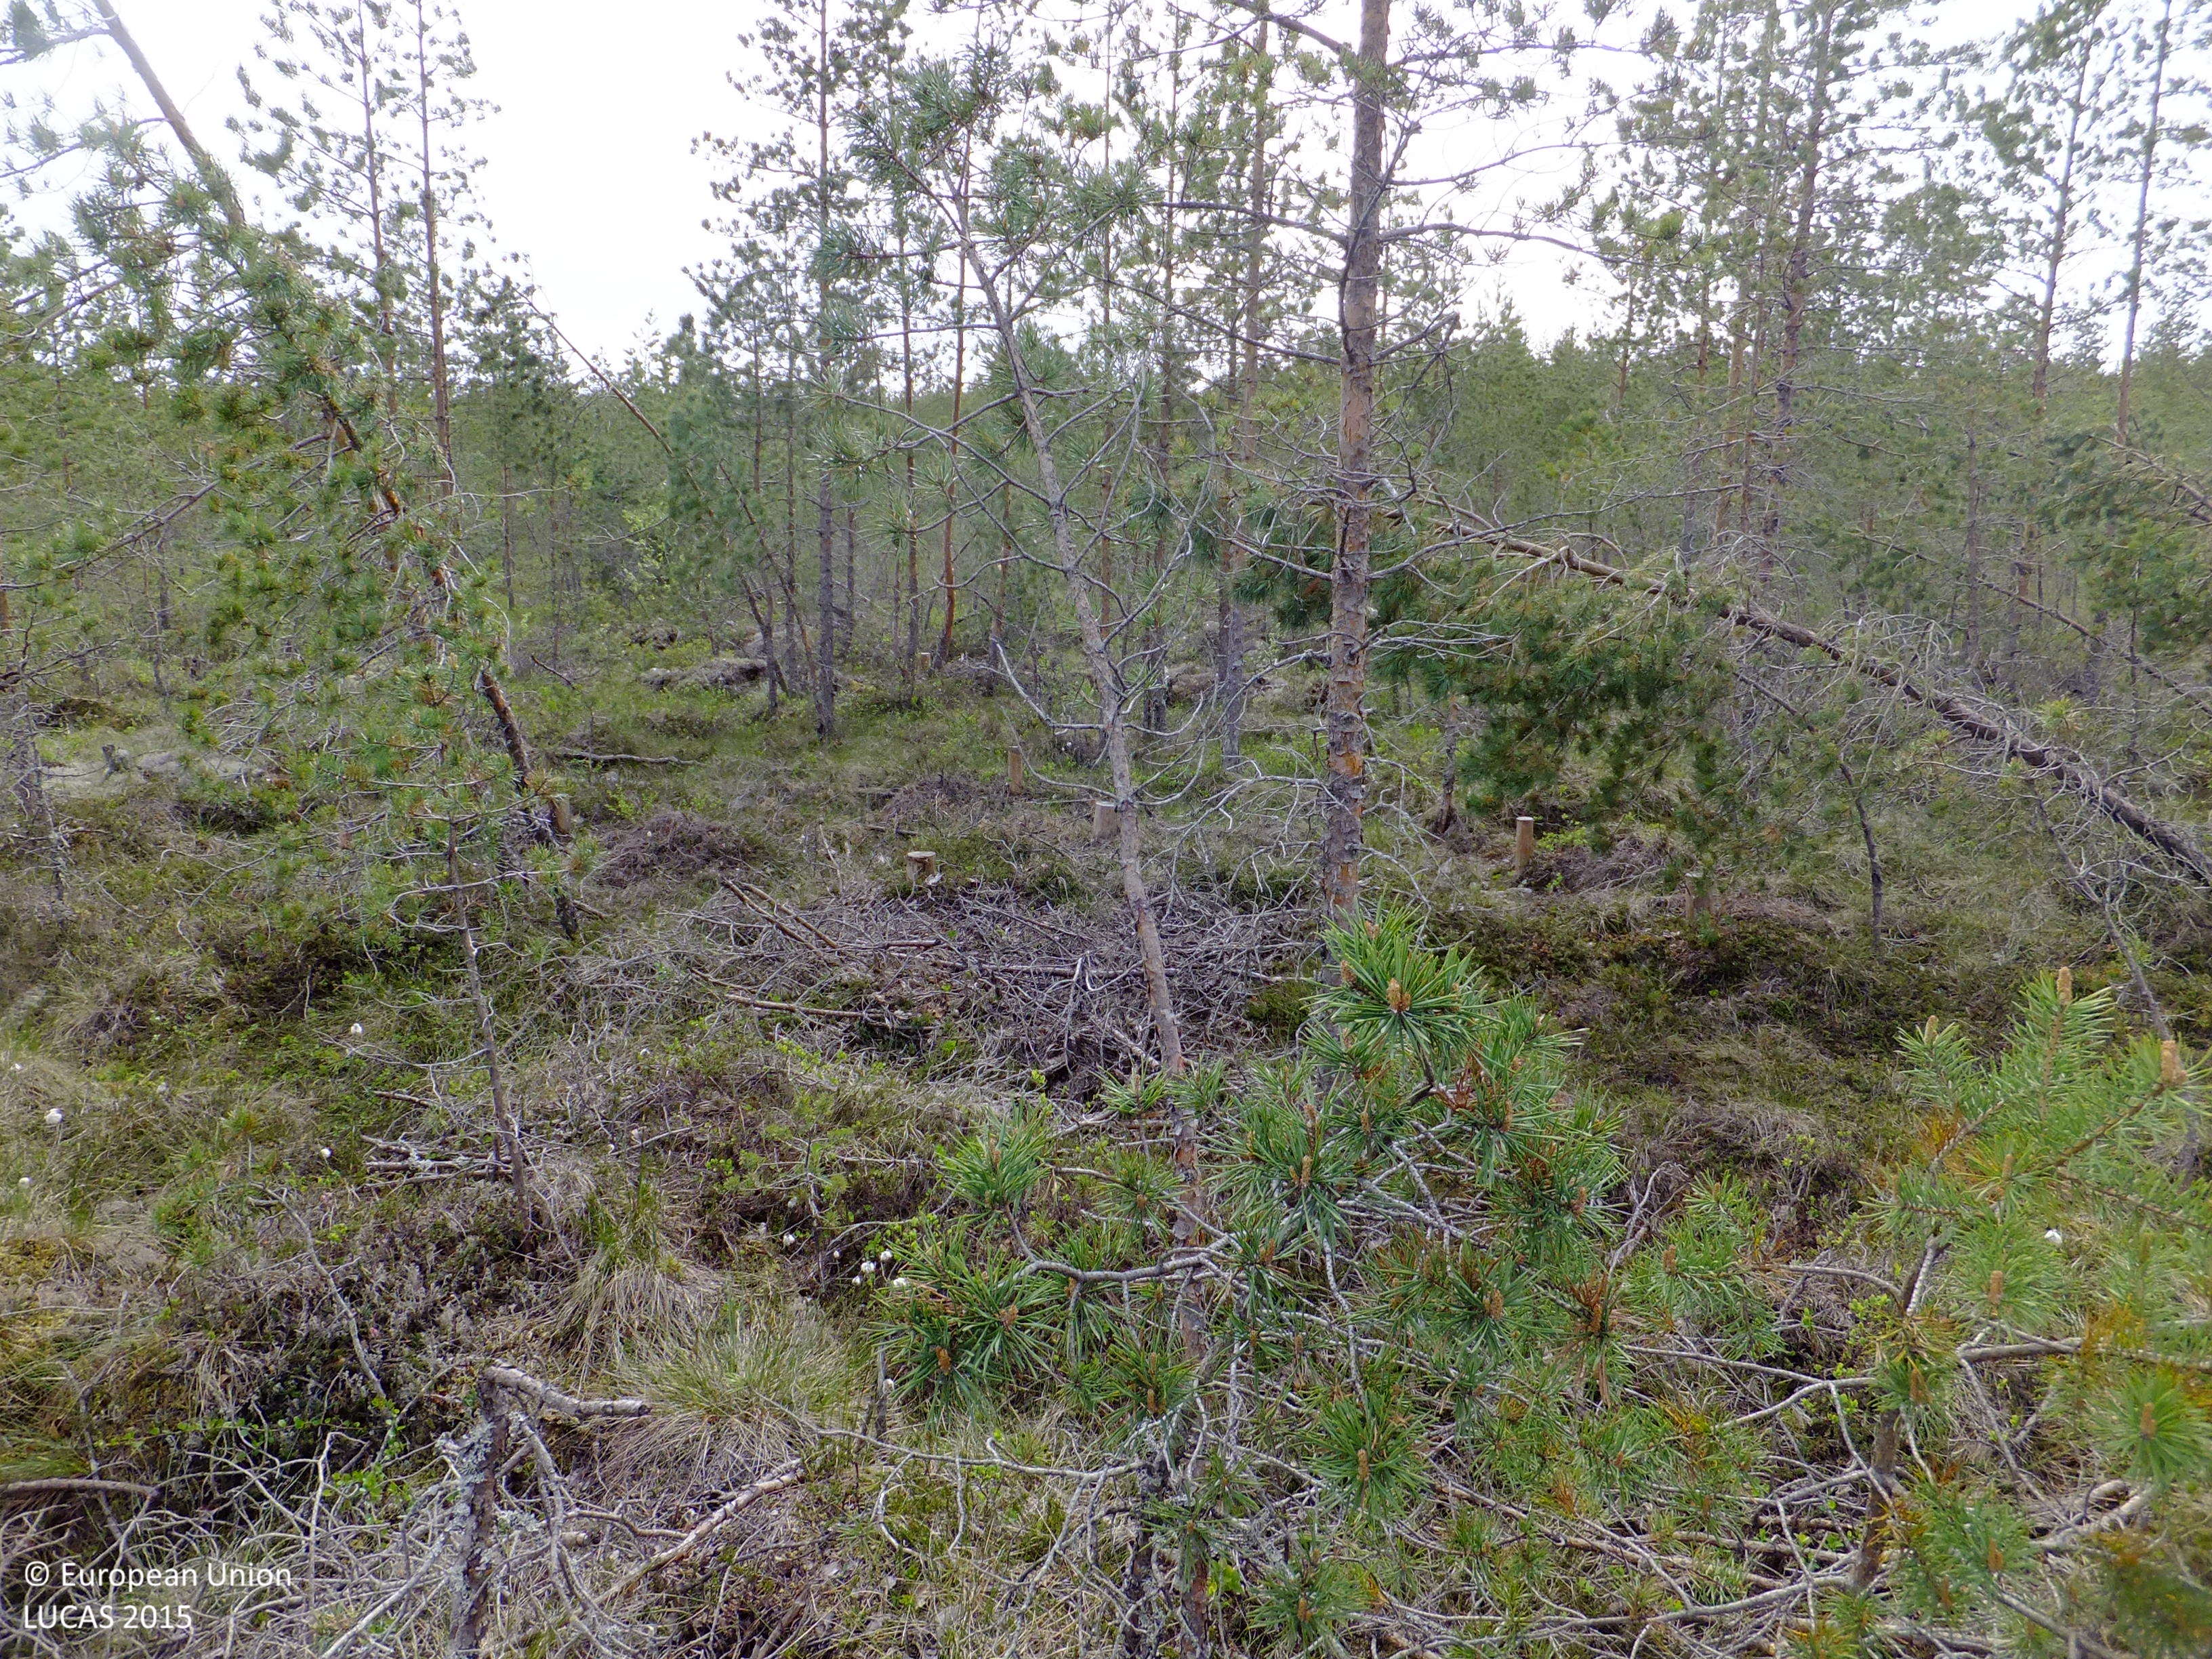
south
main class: Woodland
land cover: Pine dominated coniferous woodland
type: mire and swamp forests
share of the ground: > 75 %
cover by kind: coniferous forest trees 75 %, herbaceous plants 15 %, lichens and mosses 10 %
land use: Forestry
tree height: > 5 m
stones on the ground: < 10 %
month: June
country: FI
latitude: 63.4534
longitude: 22.8273
